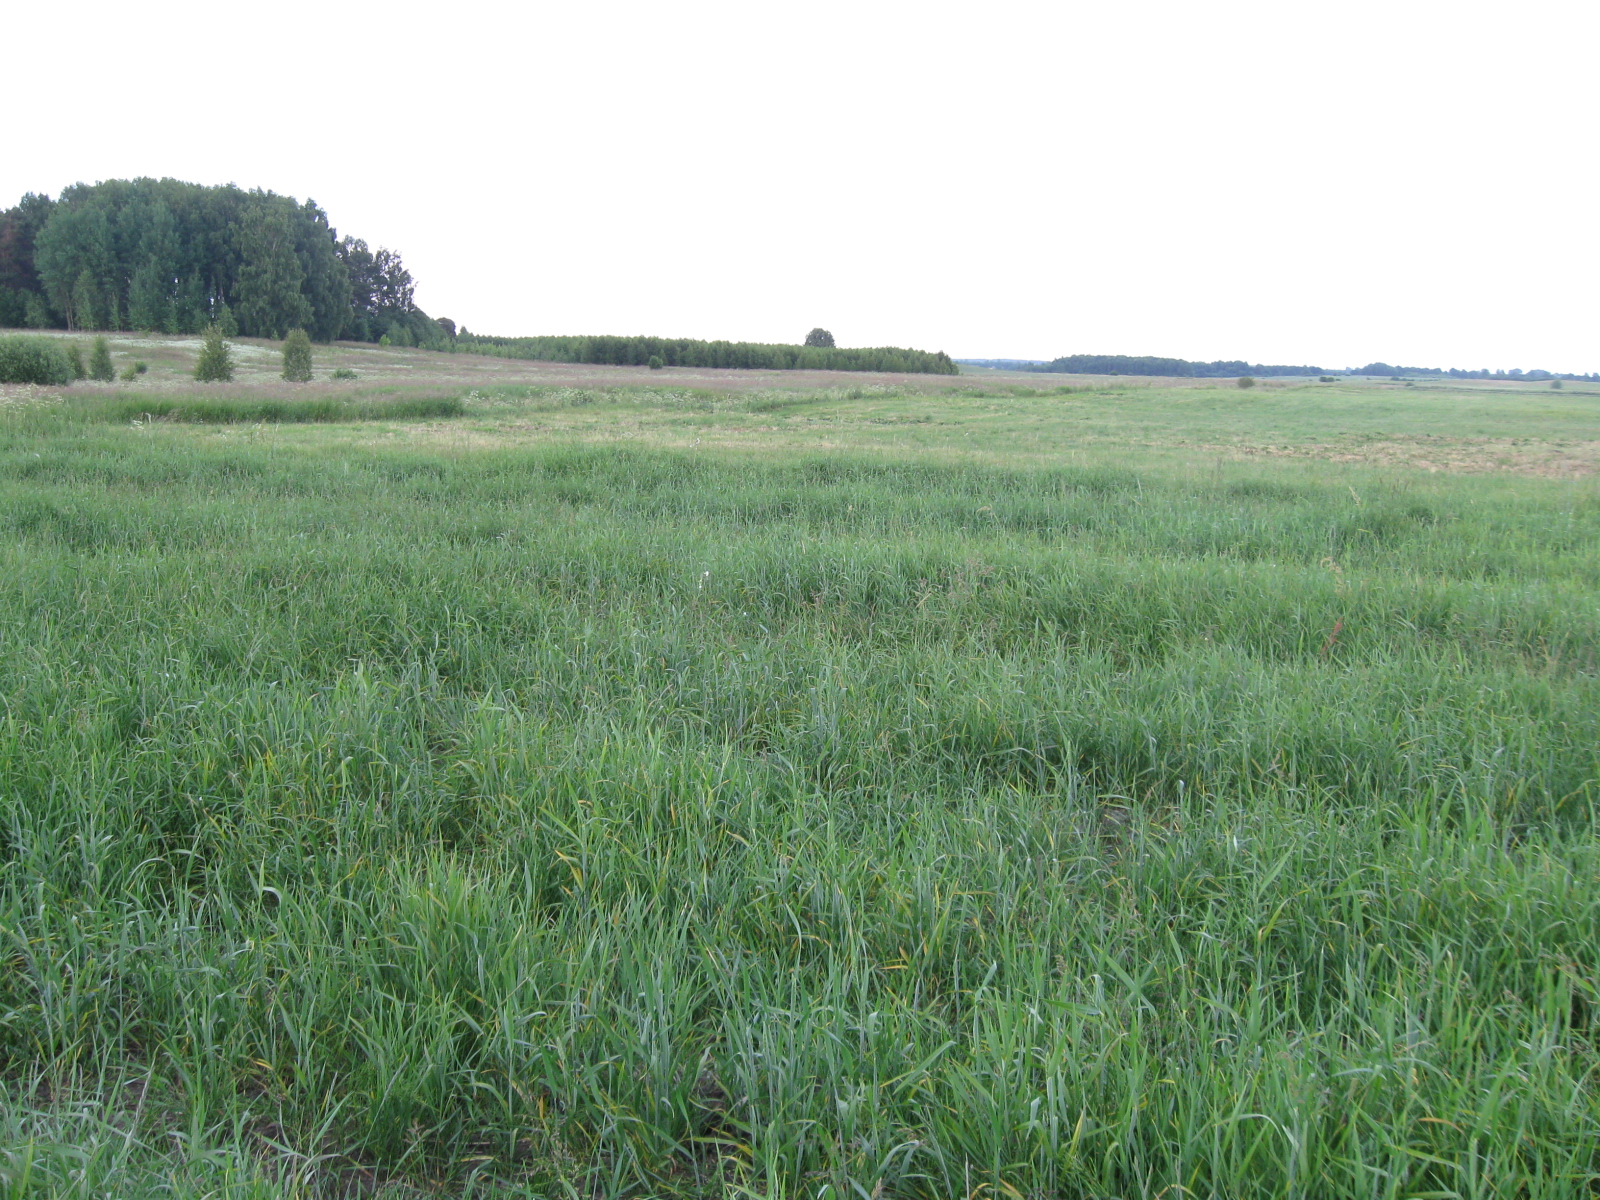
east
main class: Cropland
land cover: Common wheat
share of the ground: > 75 %
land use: Agriculture (excluding fallow land and kitchen gardens)
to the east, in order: Common wheat; Grassland without tree/shrub cover; Ditches and canals; Grassland without tree/shrub cover
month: June
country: LT
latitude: 54.8586
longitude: 24.5441
